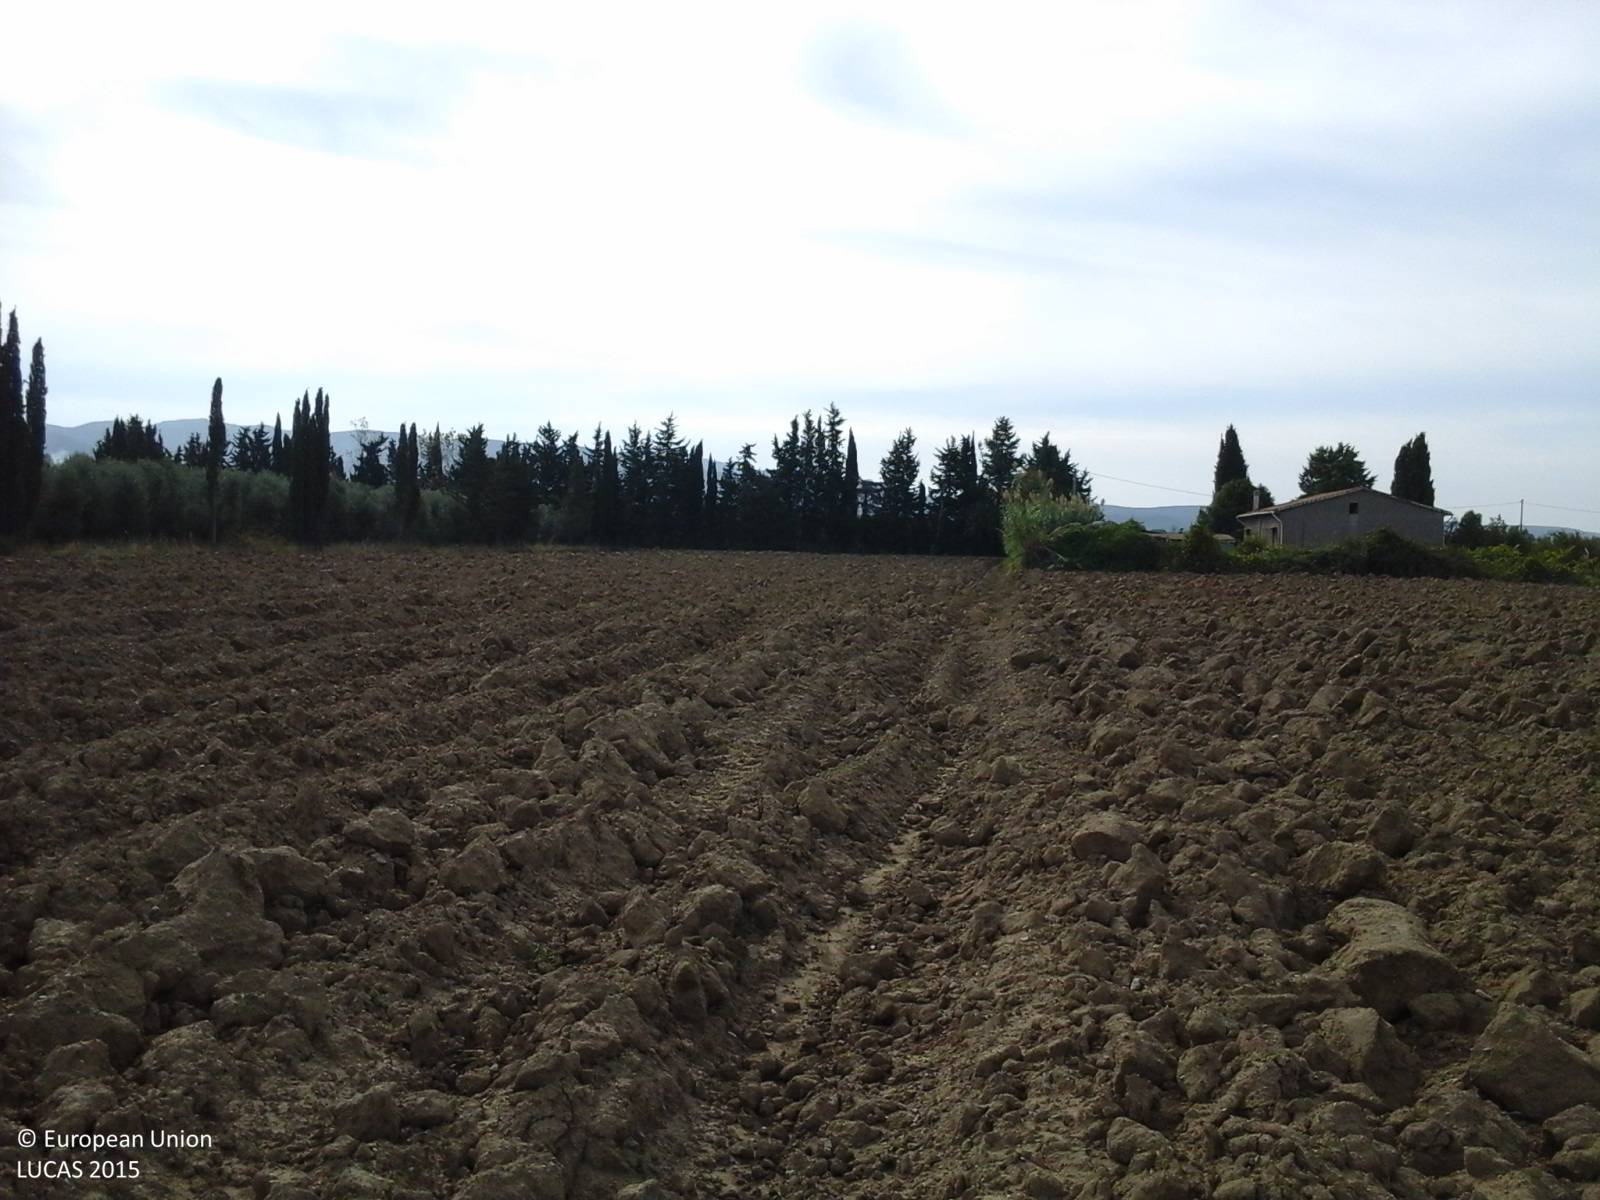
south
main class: Cropland
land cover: Tomatoes
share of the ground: < 10 %
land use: Agriculture (excluding fallow land and kitchen gardens)
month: October
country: IT
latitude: 43.1941
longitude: 10.5766
